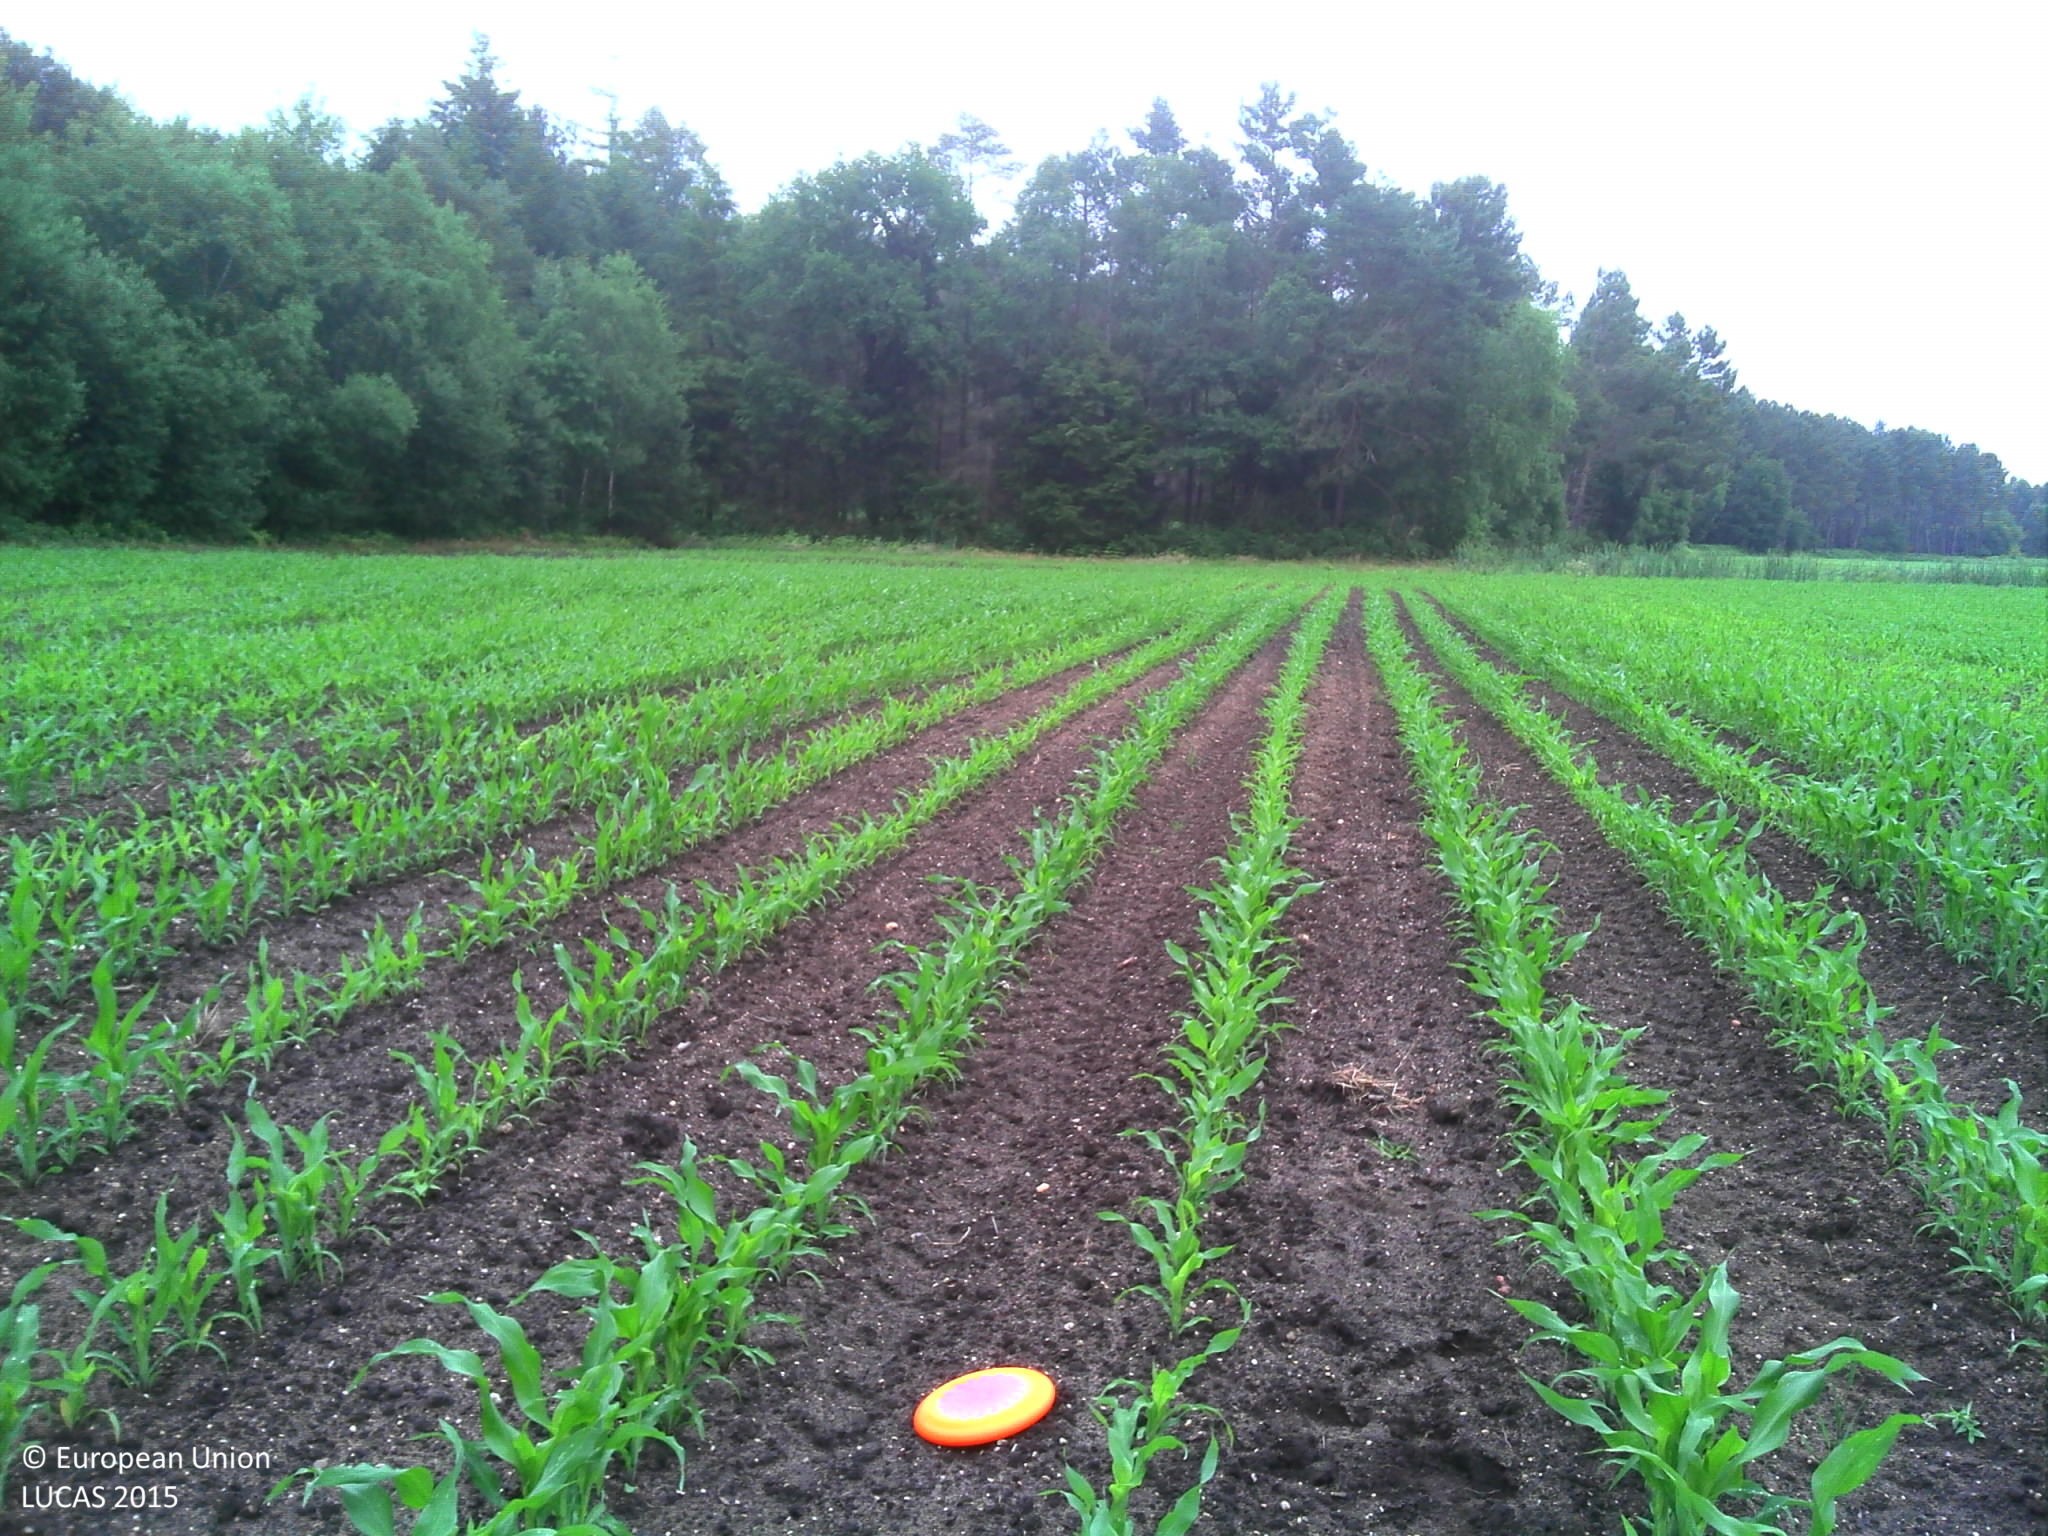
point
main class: Cropland
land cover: Maize
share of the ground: 25 - 50 %
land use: Agriculture (excluding fallow land and kitchen gardens)
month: June
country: FR
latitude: 47.4500
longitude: 0.0944
